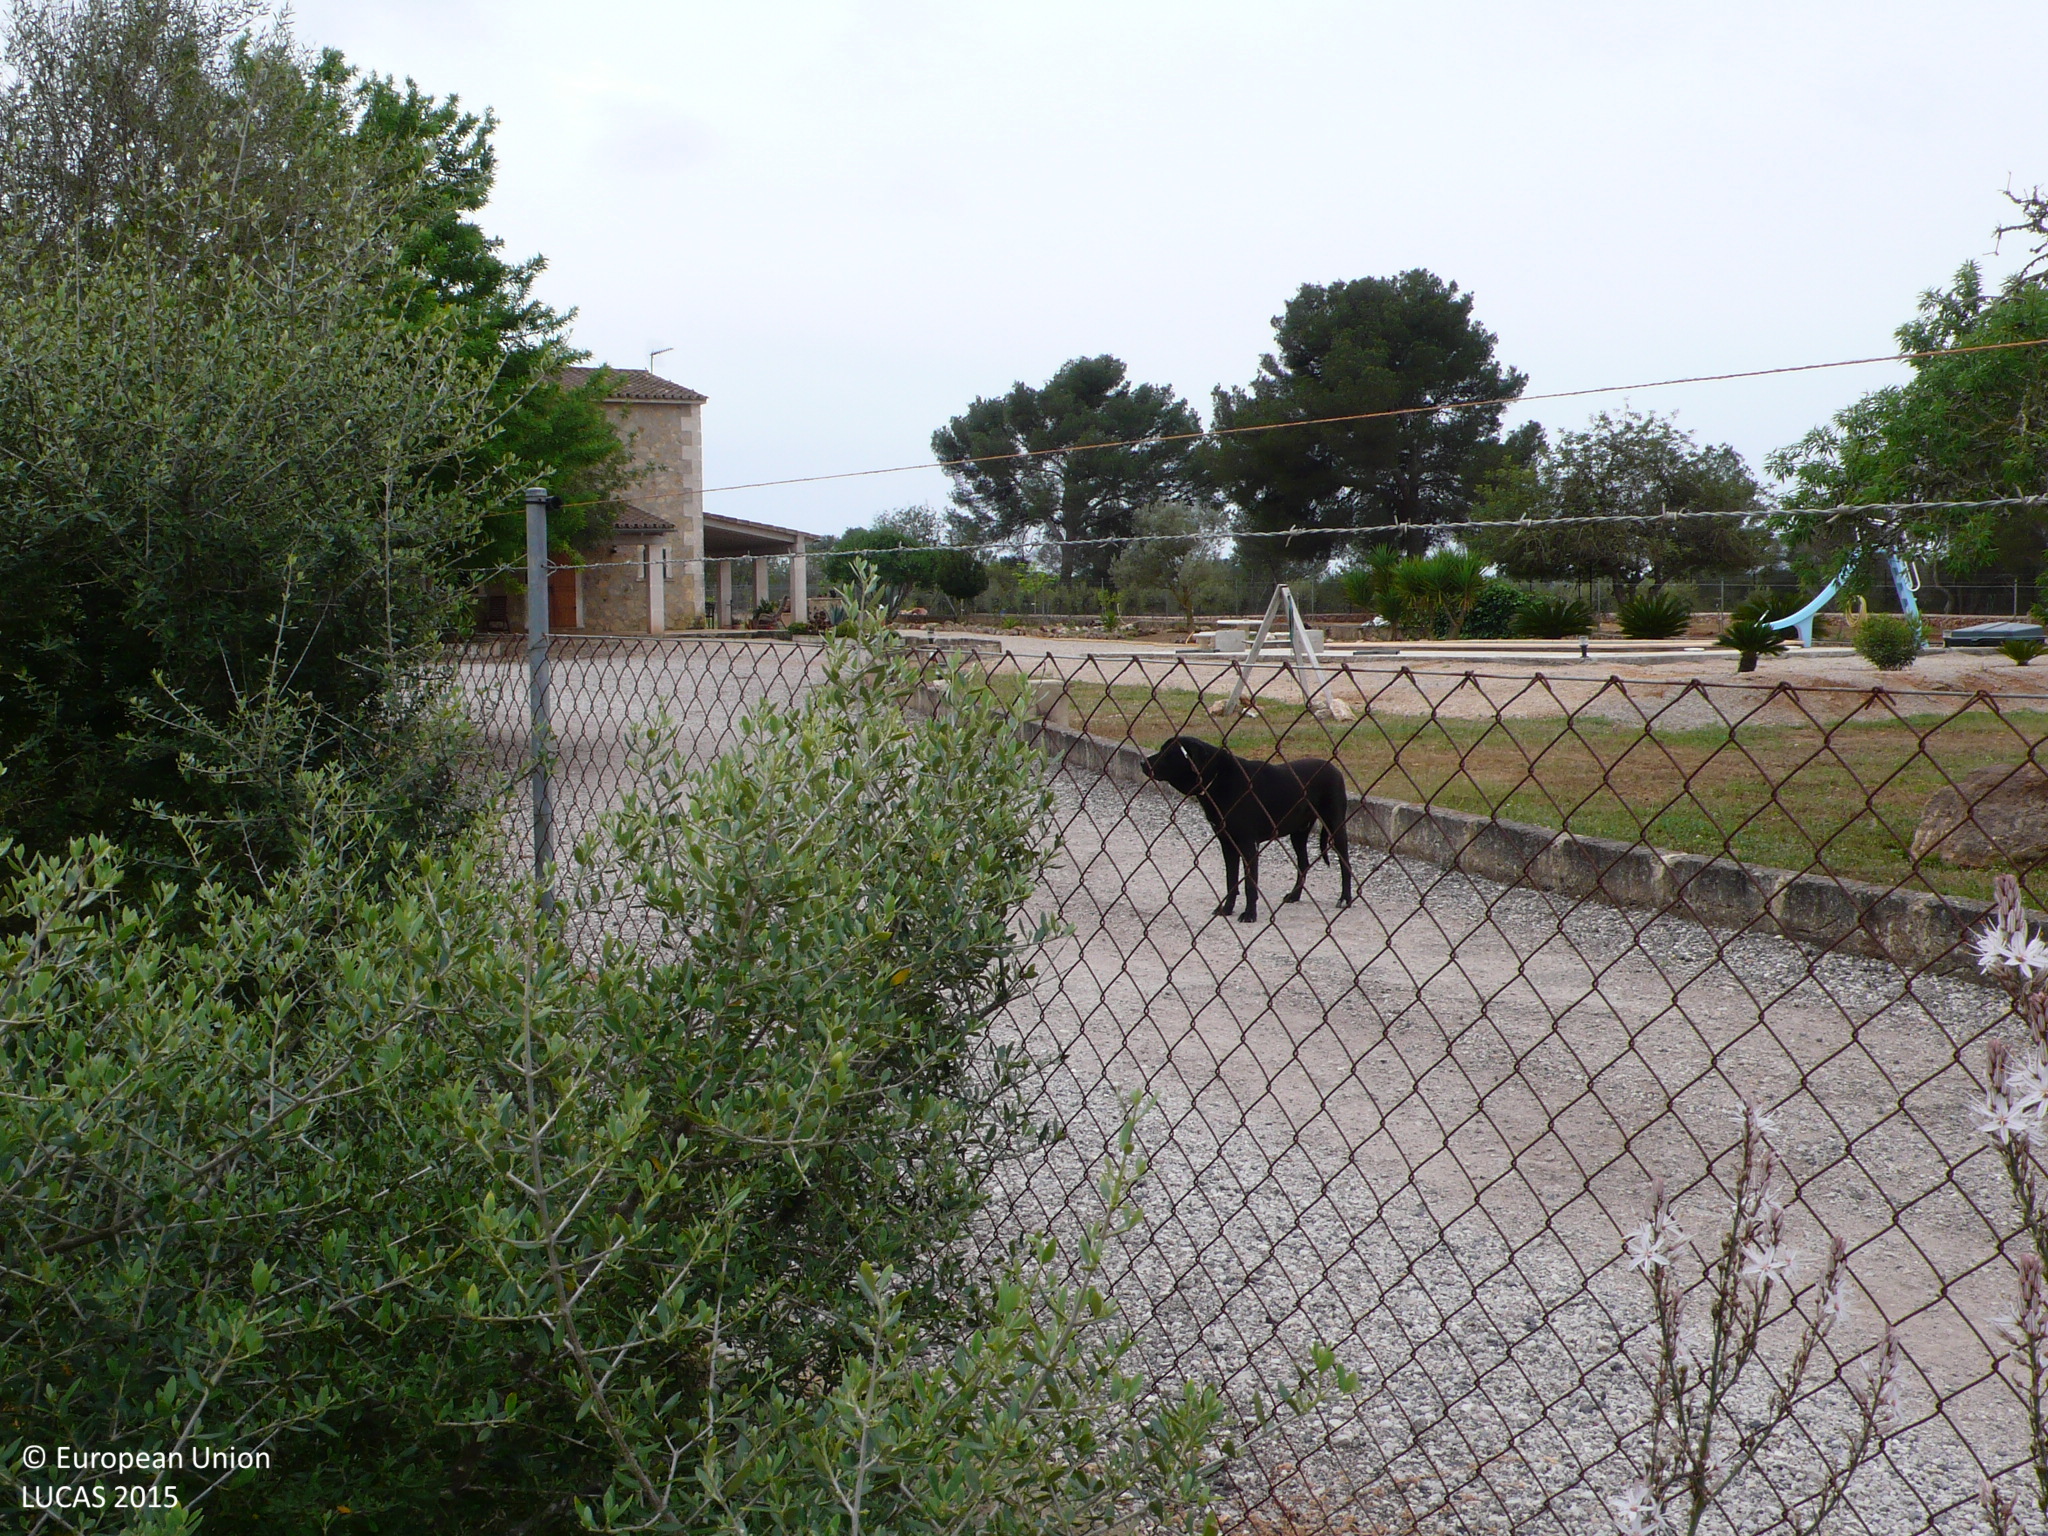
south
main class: Grassland
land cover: Grassland with sparse tree/shrub cover
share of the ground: > 75 %
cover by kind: herbaceous plants 75 %, consolidated bare surface 20 %, broadleaved forest trees 5 %
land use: Residential
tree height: < 5 m
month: April
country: ES
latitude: 39.5898
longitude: 2.8692
